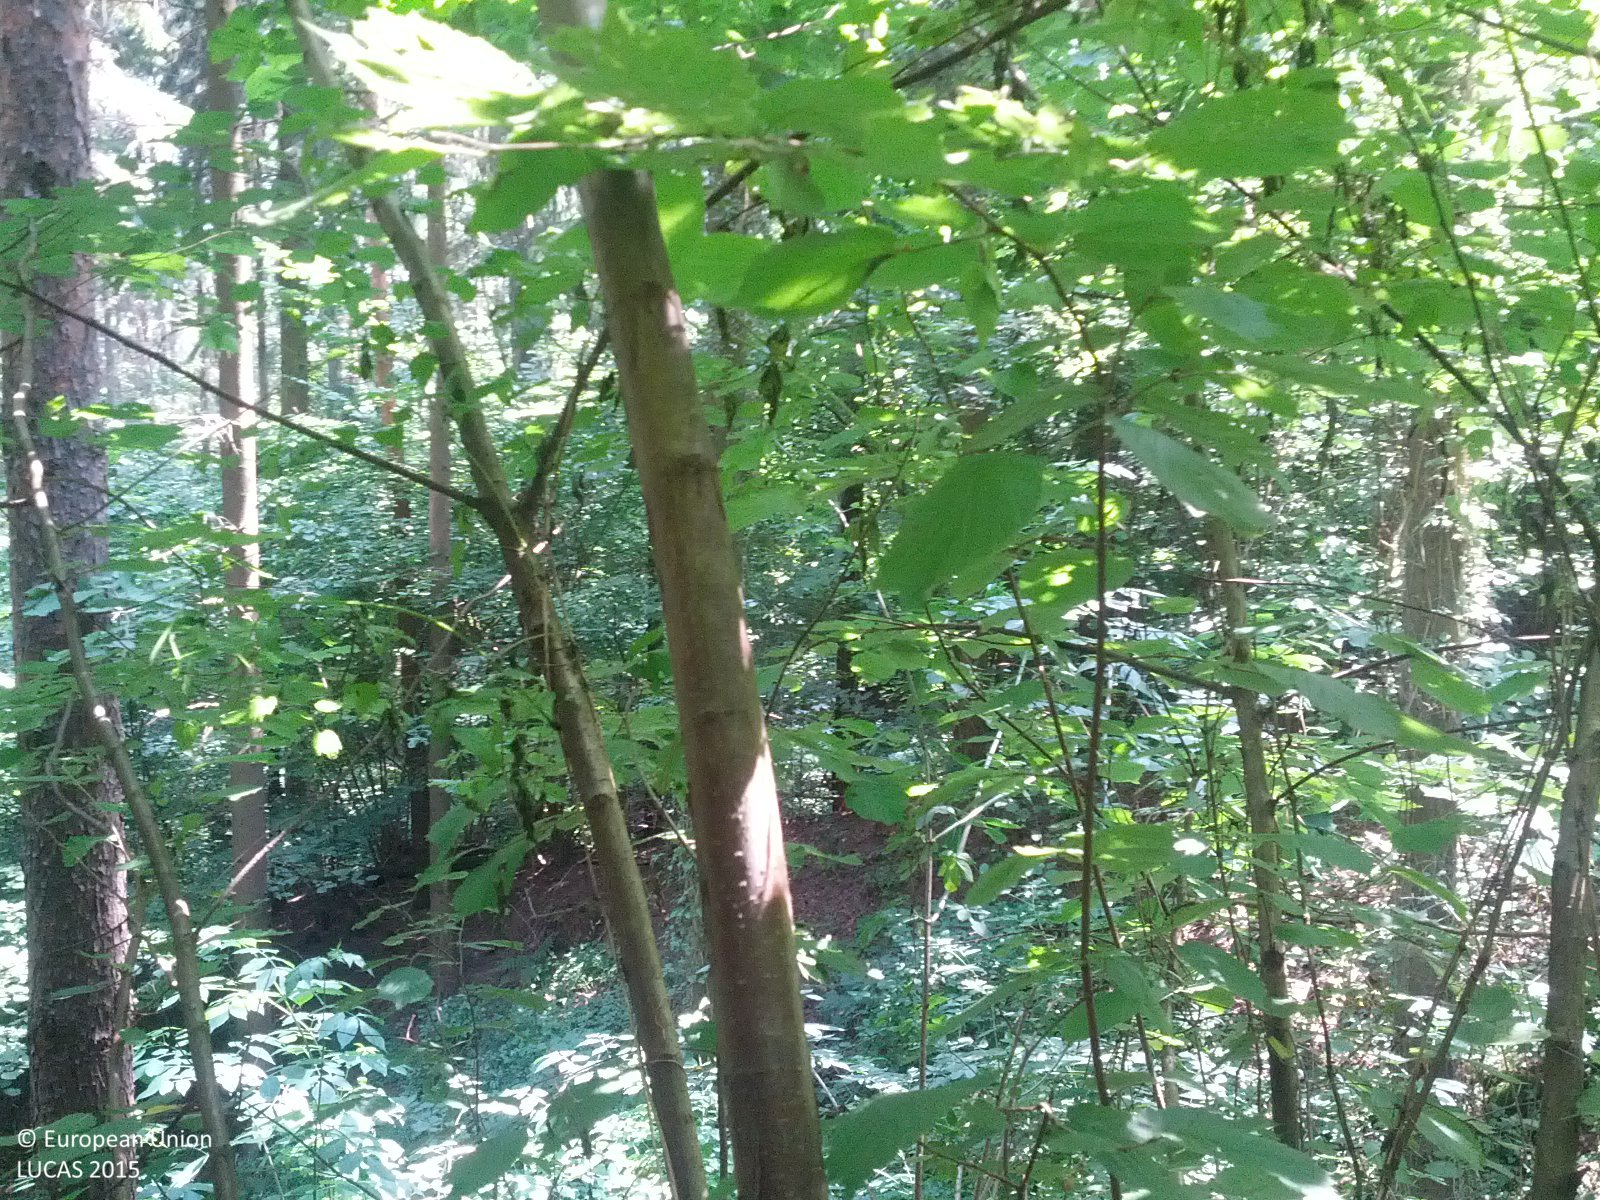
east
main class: Woodland
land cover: Pine dominated mixed woodland
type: hemiboreal forest and nemoral coniferous forest and mixed broadleaved-coniferous forest
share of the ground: > 75 %
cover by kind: coniferous forest trees 65 %, broadleaved forest trees 25 %, shrubs 5 %, herbaceous plants 5 %
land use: Forestry
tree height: > 5 m
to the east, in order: Pine dominated mixed woodland; Spruce dominated coniferous woodland; Groves; Tracks; Groves; Pine dominated mixed woodland
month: July
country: AT
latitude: 48.5366
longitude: 16.1943
